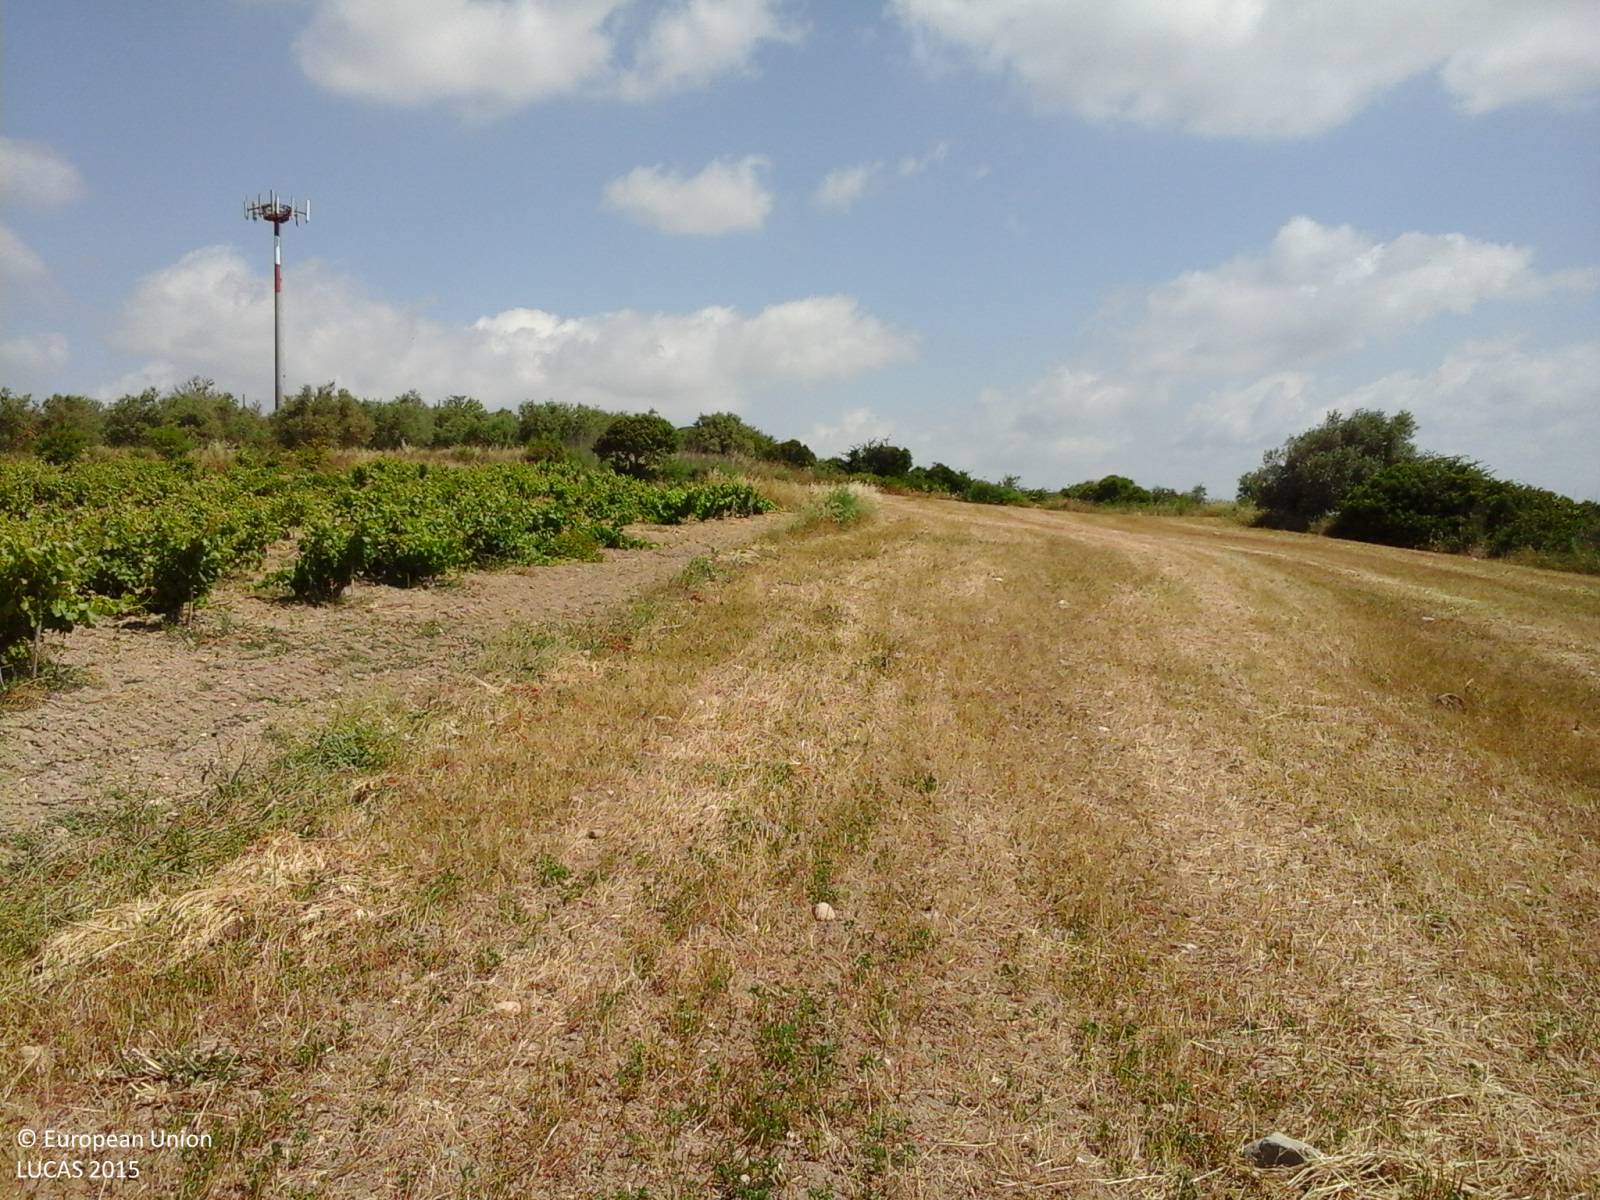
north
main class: Cropland
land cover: Temporary grasslands
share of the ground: > 75 %
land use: Agriculture (excluding fallow land and kitchen gardens)
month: May
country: IT
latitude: 39.7898
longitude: 8.8504
